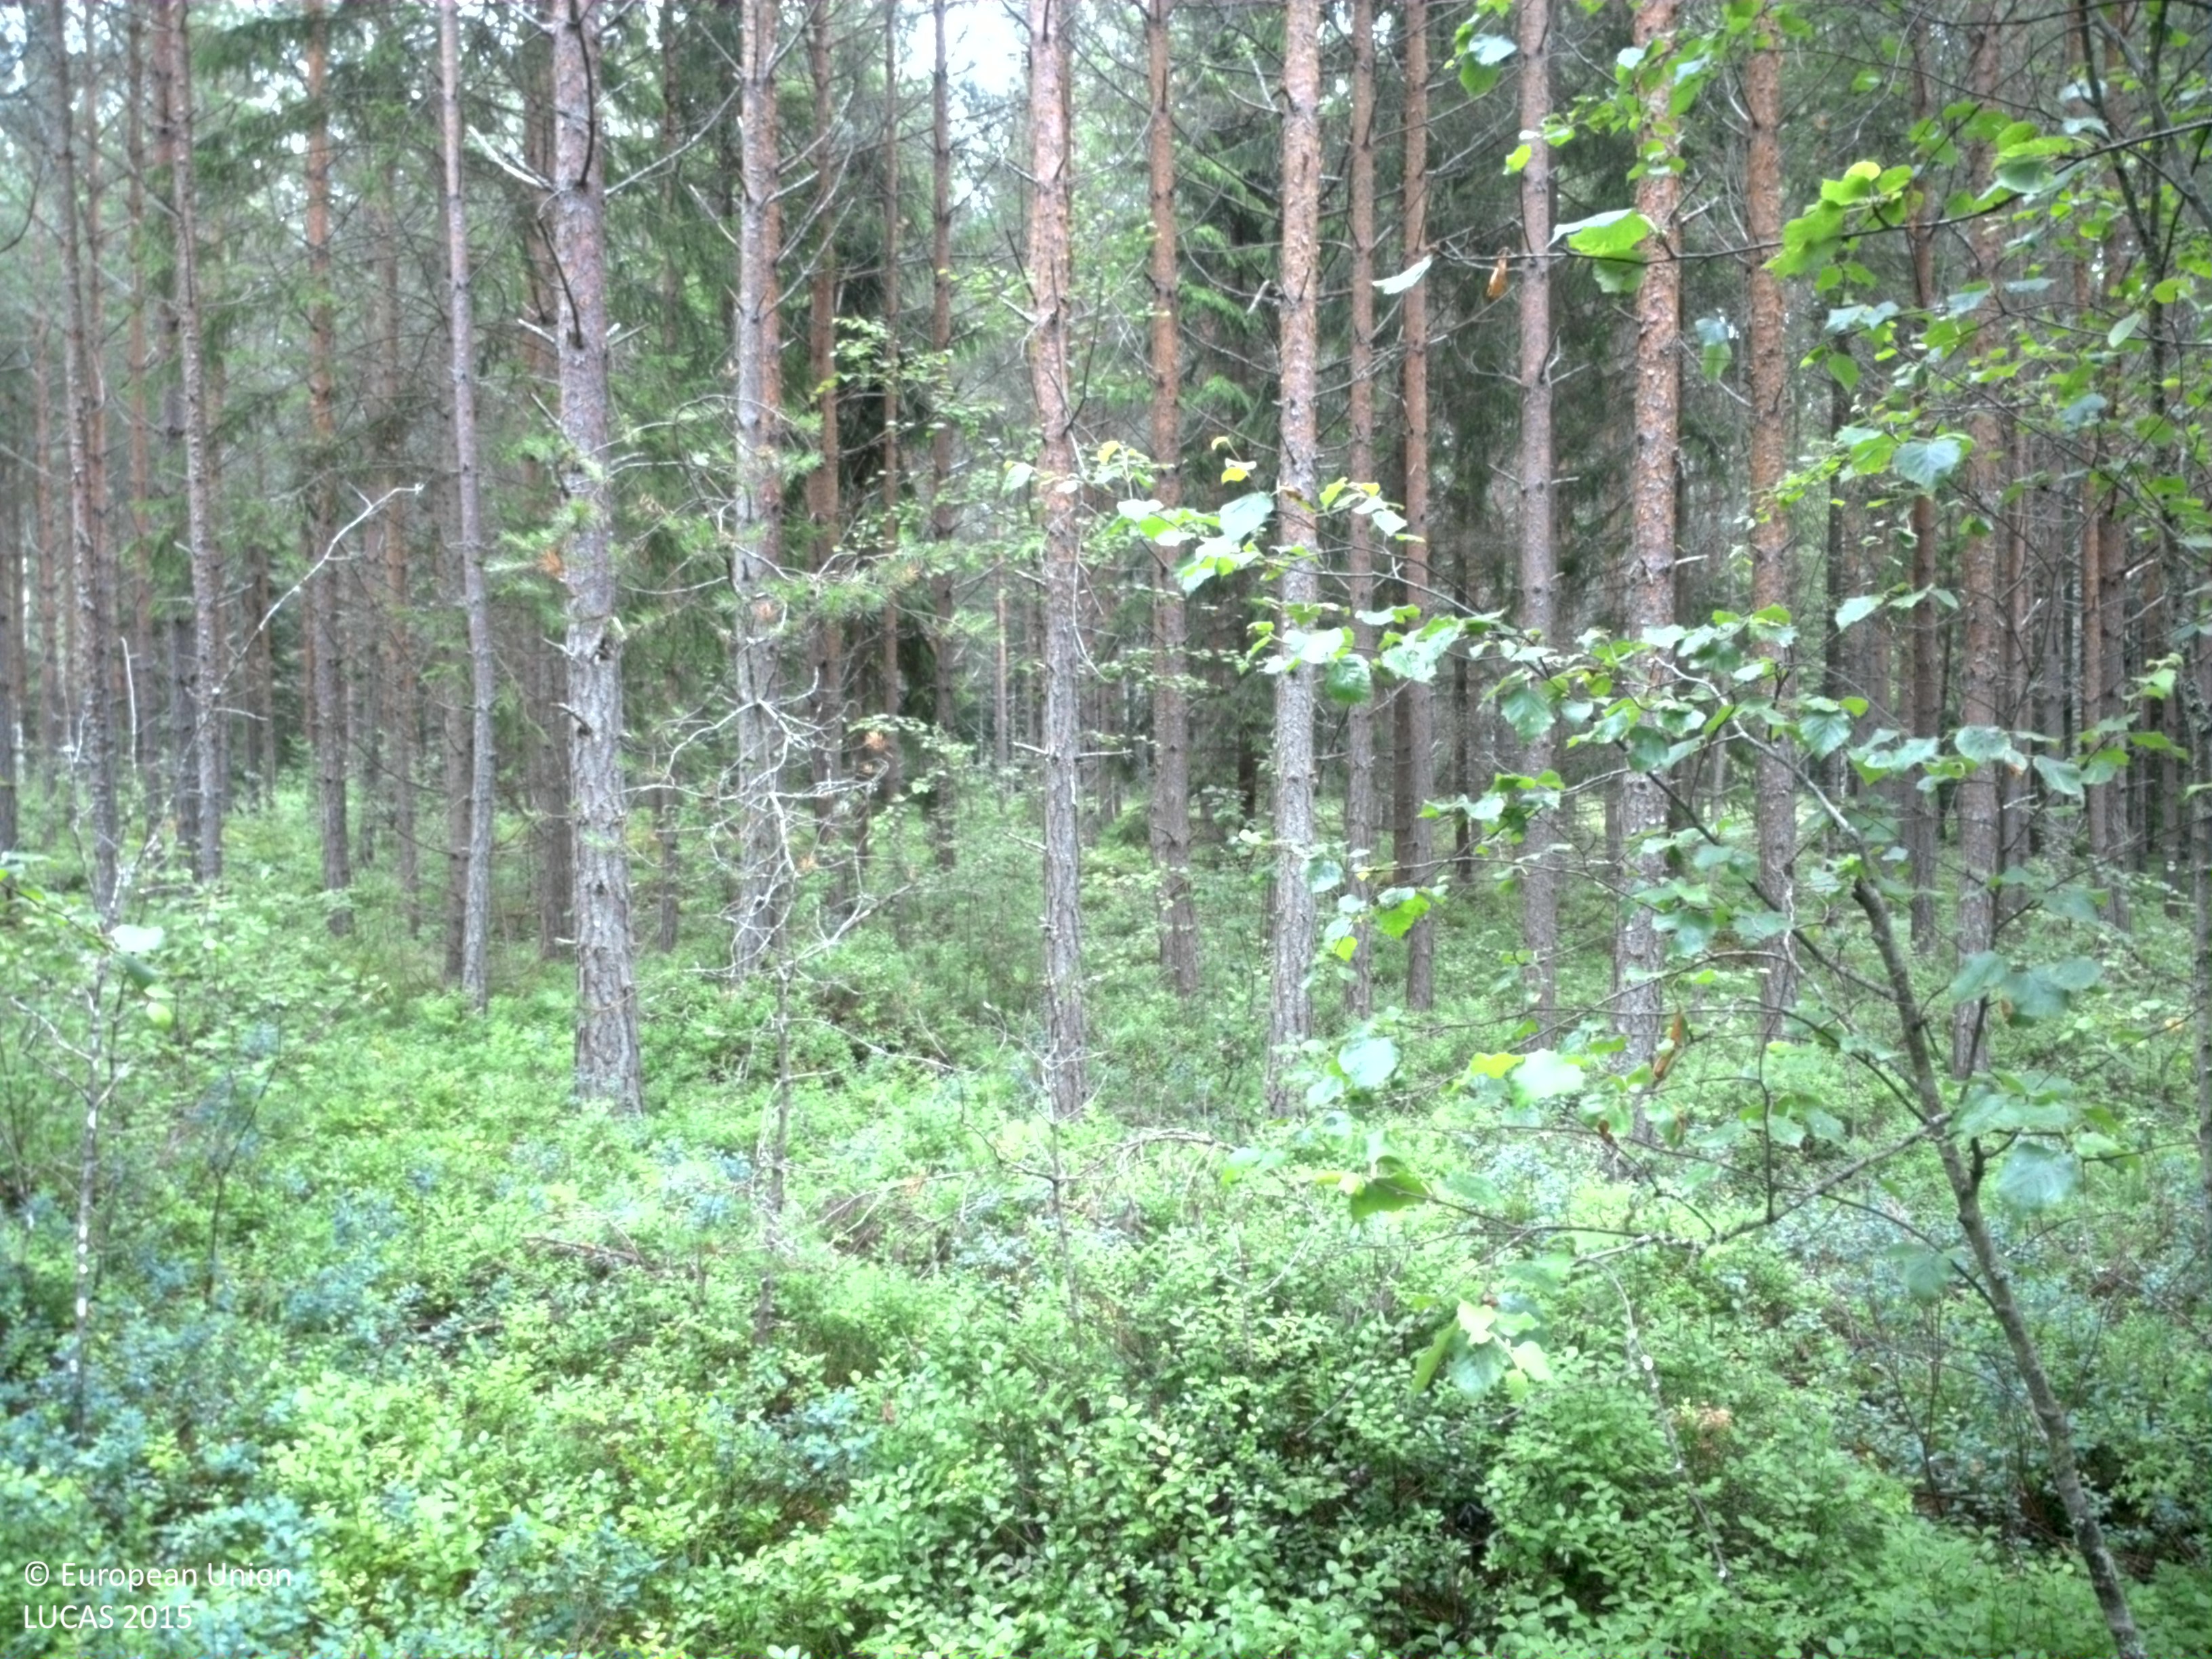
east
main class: Woodland
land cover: Pine dominated coniferous woodland
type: boreal forest
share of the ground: 50 - 75 %
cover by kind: coniferous forest trees 65 %, shrubs 20 %, lichens and mosses 10 %, broadleaved forest trees 5 %
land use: Forestry
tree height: > 5 m
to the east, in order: Pine dominated coniferous woodland; Paved roads, cycling and walking lanes; Pine dominated mixed woodland; Electric lines; Pine dominated coniferous woodland; Pine dominated mixed woodland
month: July
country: SE
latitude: 59.3670
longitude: 13.3179
